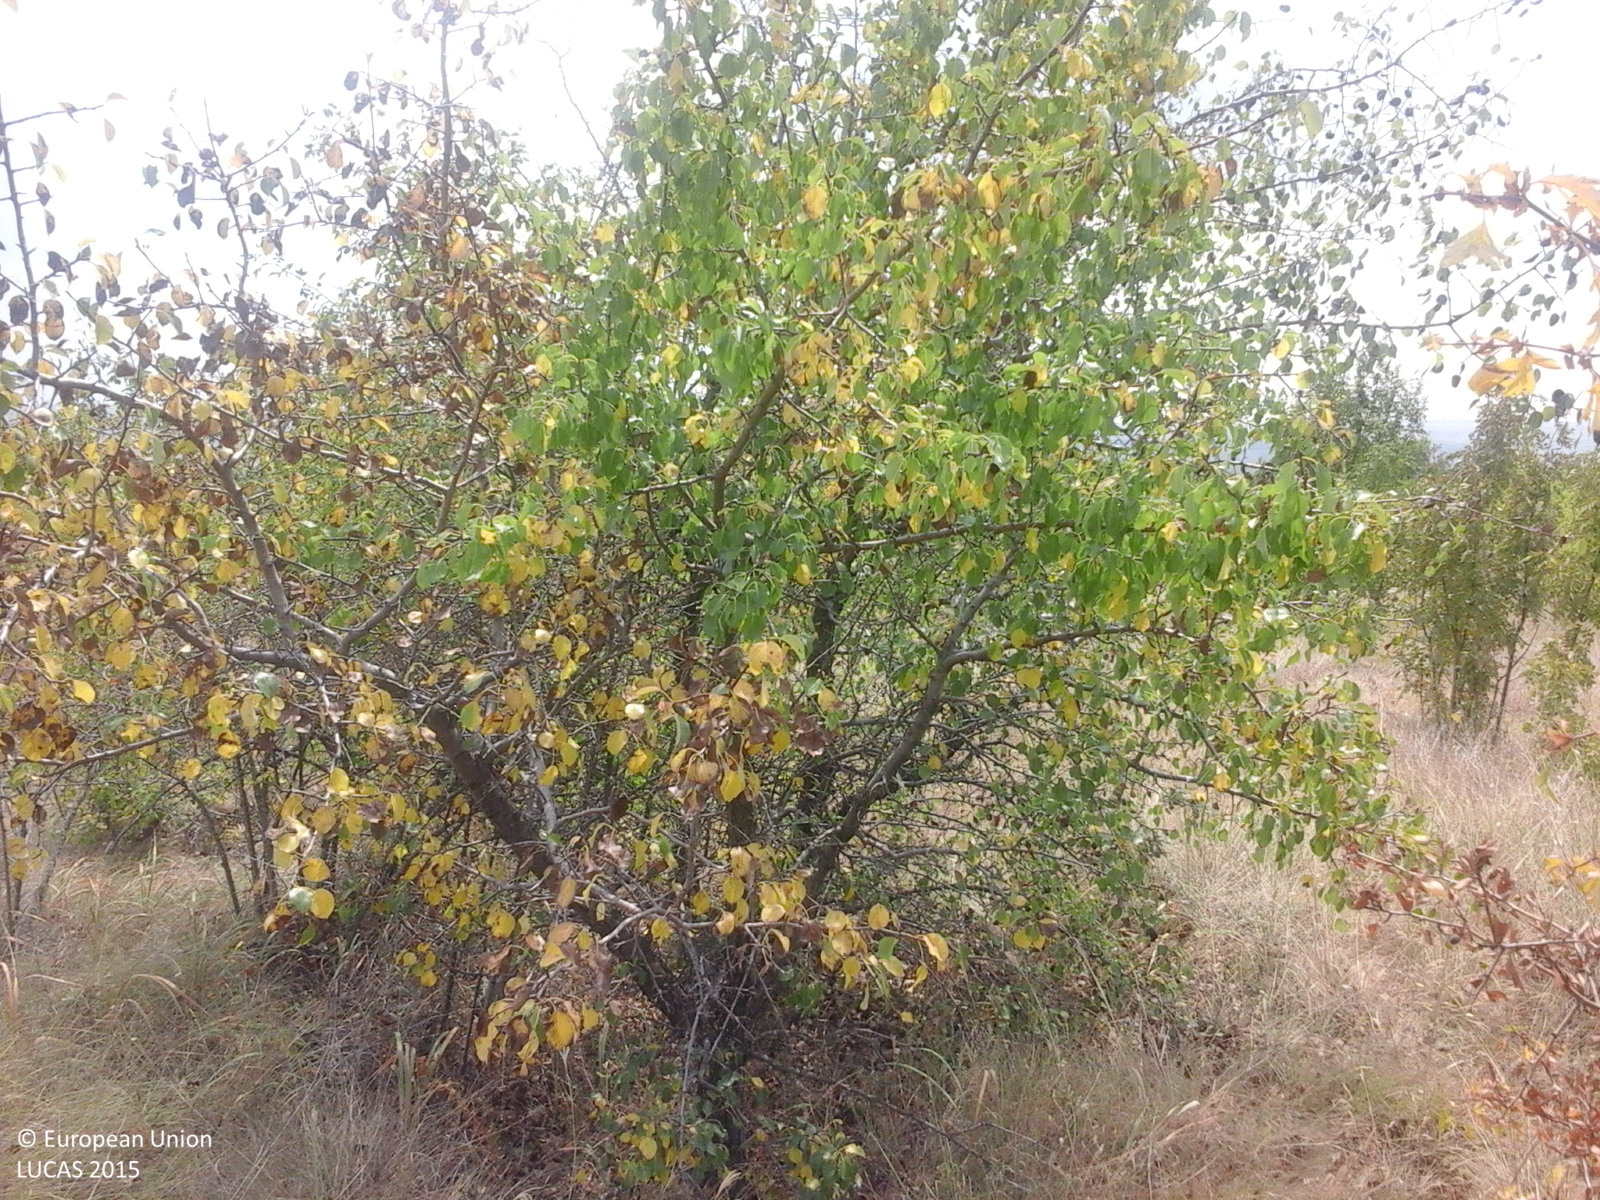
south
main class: Grassland
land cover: Grassland with sparse tree/shrub cover
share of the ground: > 75 %
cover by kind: herbaceous plants 95 %, broadleaved forest trees 5 %
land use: Fallow land
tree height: < 5 m
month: July
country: RO
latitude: 44.9033
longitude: 28.2948
